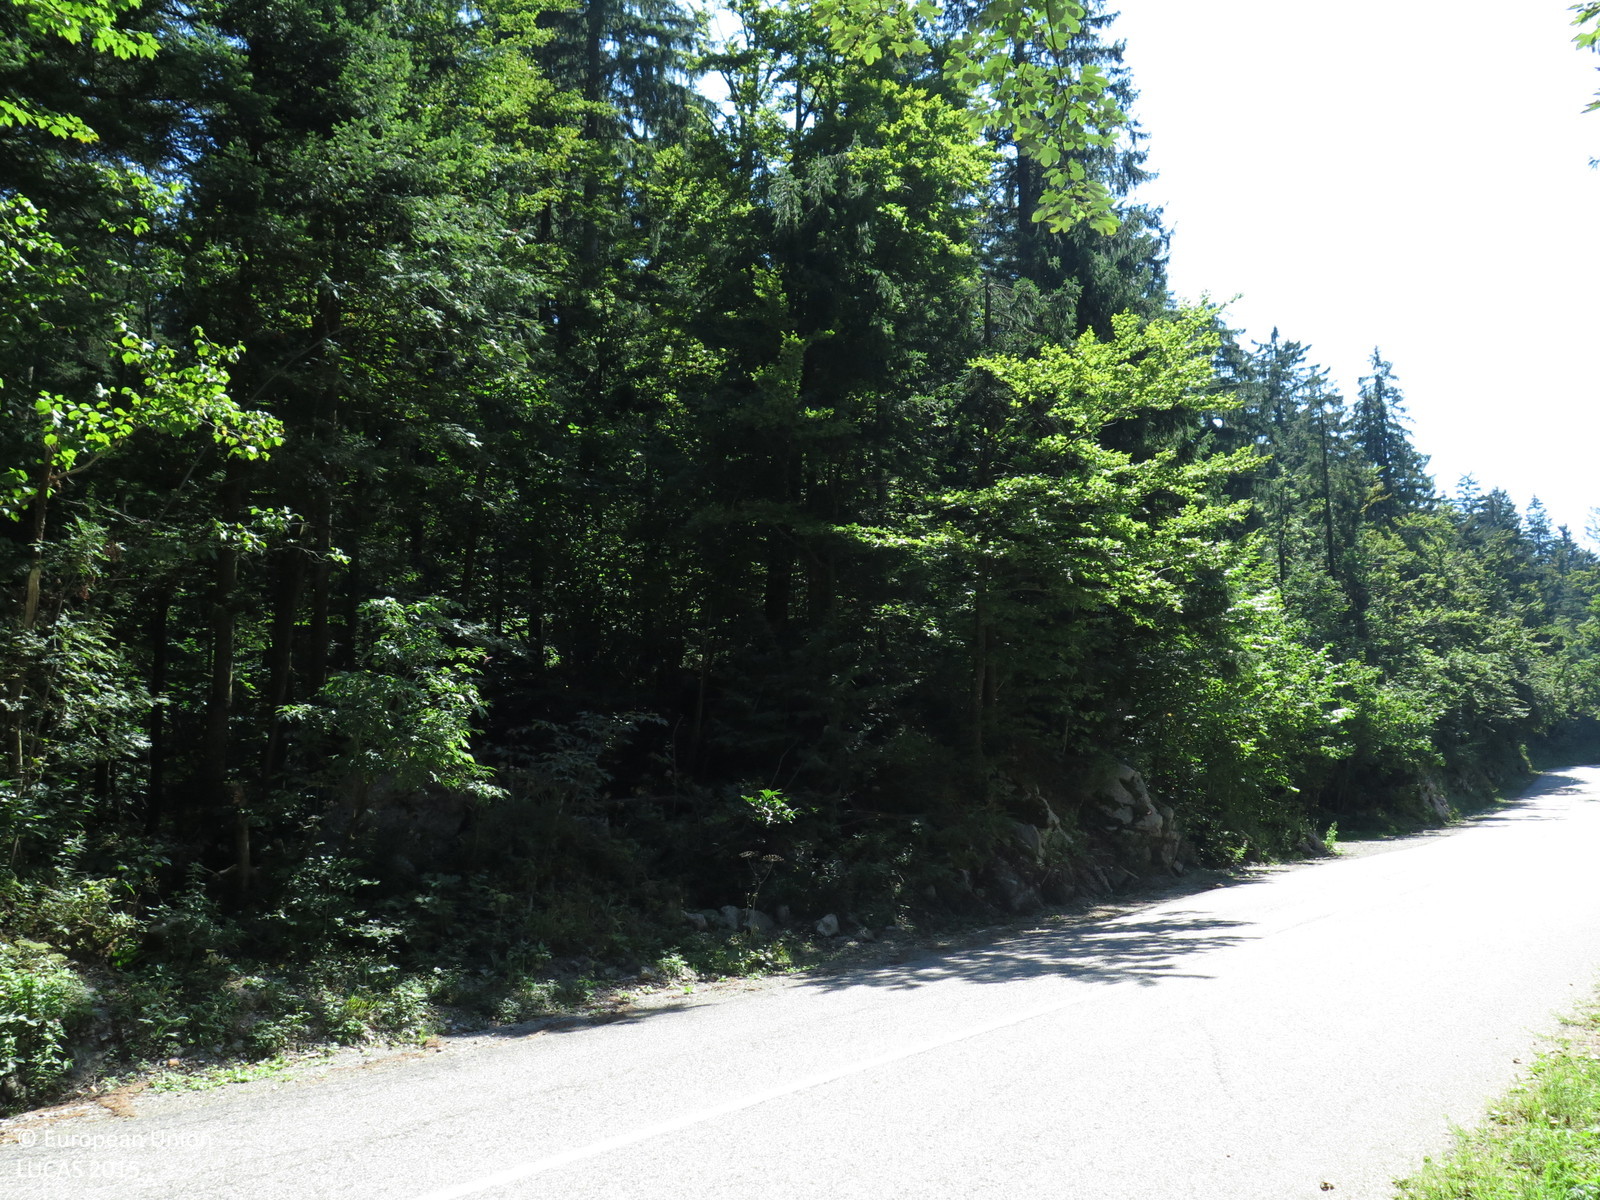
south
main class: Woodland
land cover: Other mixed woodland
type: mountainous beech forest
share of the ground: > 75 %
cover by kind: coniferous forest trees 75 %, broadleaved forest trees 25 %
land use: Forestry
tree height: > 5 m
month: August
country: HR
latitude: 45.3431
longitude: 14.7554
